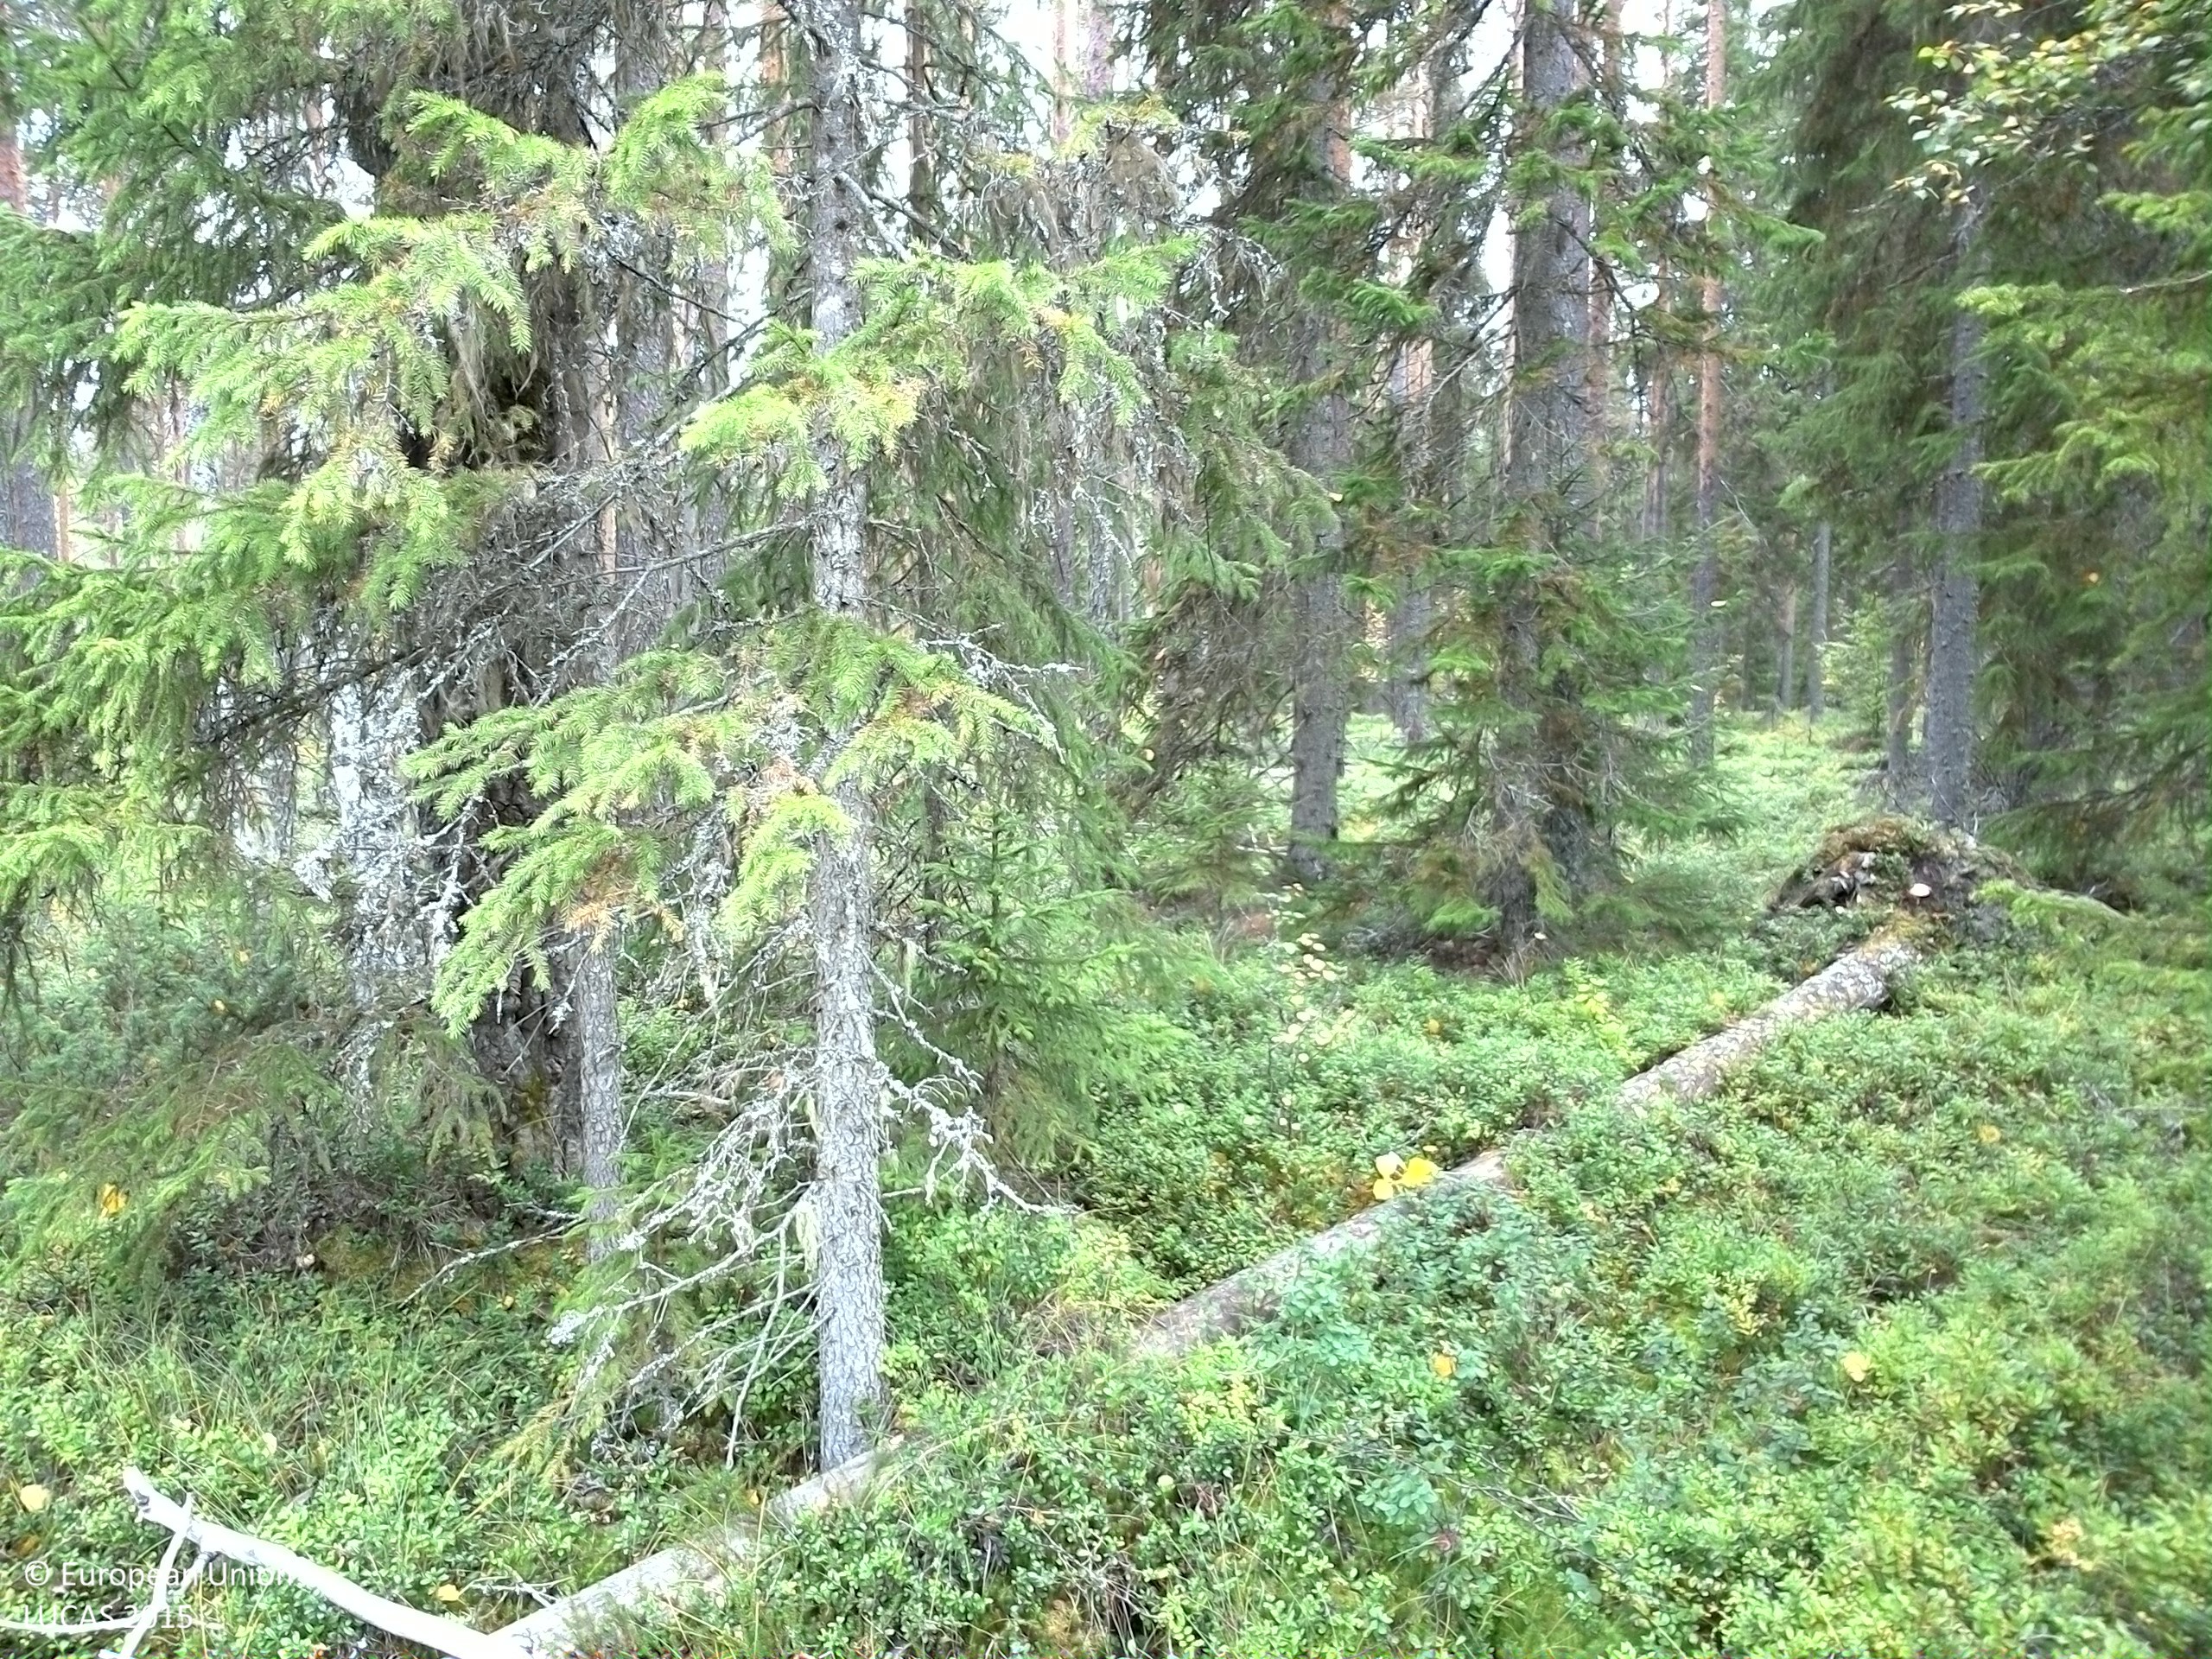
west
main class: Woodland
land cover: Other mixed woodland
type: boreal forest
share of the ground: 25 - 50 %
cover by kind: coniferous forest trees 35 %, broadleaved forest trees 30 %, lichens and mosses 20 %, shrubs 15 %
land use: Forestry
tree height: > 5 m
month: September
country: SE
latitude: 61.6409
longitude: 15.0981
